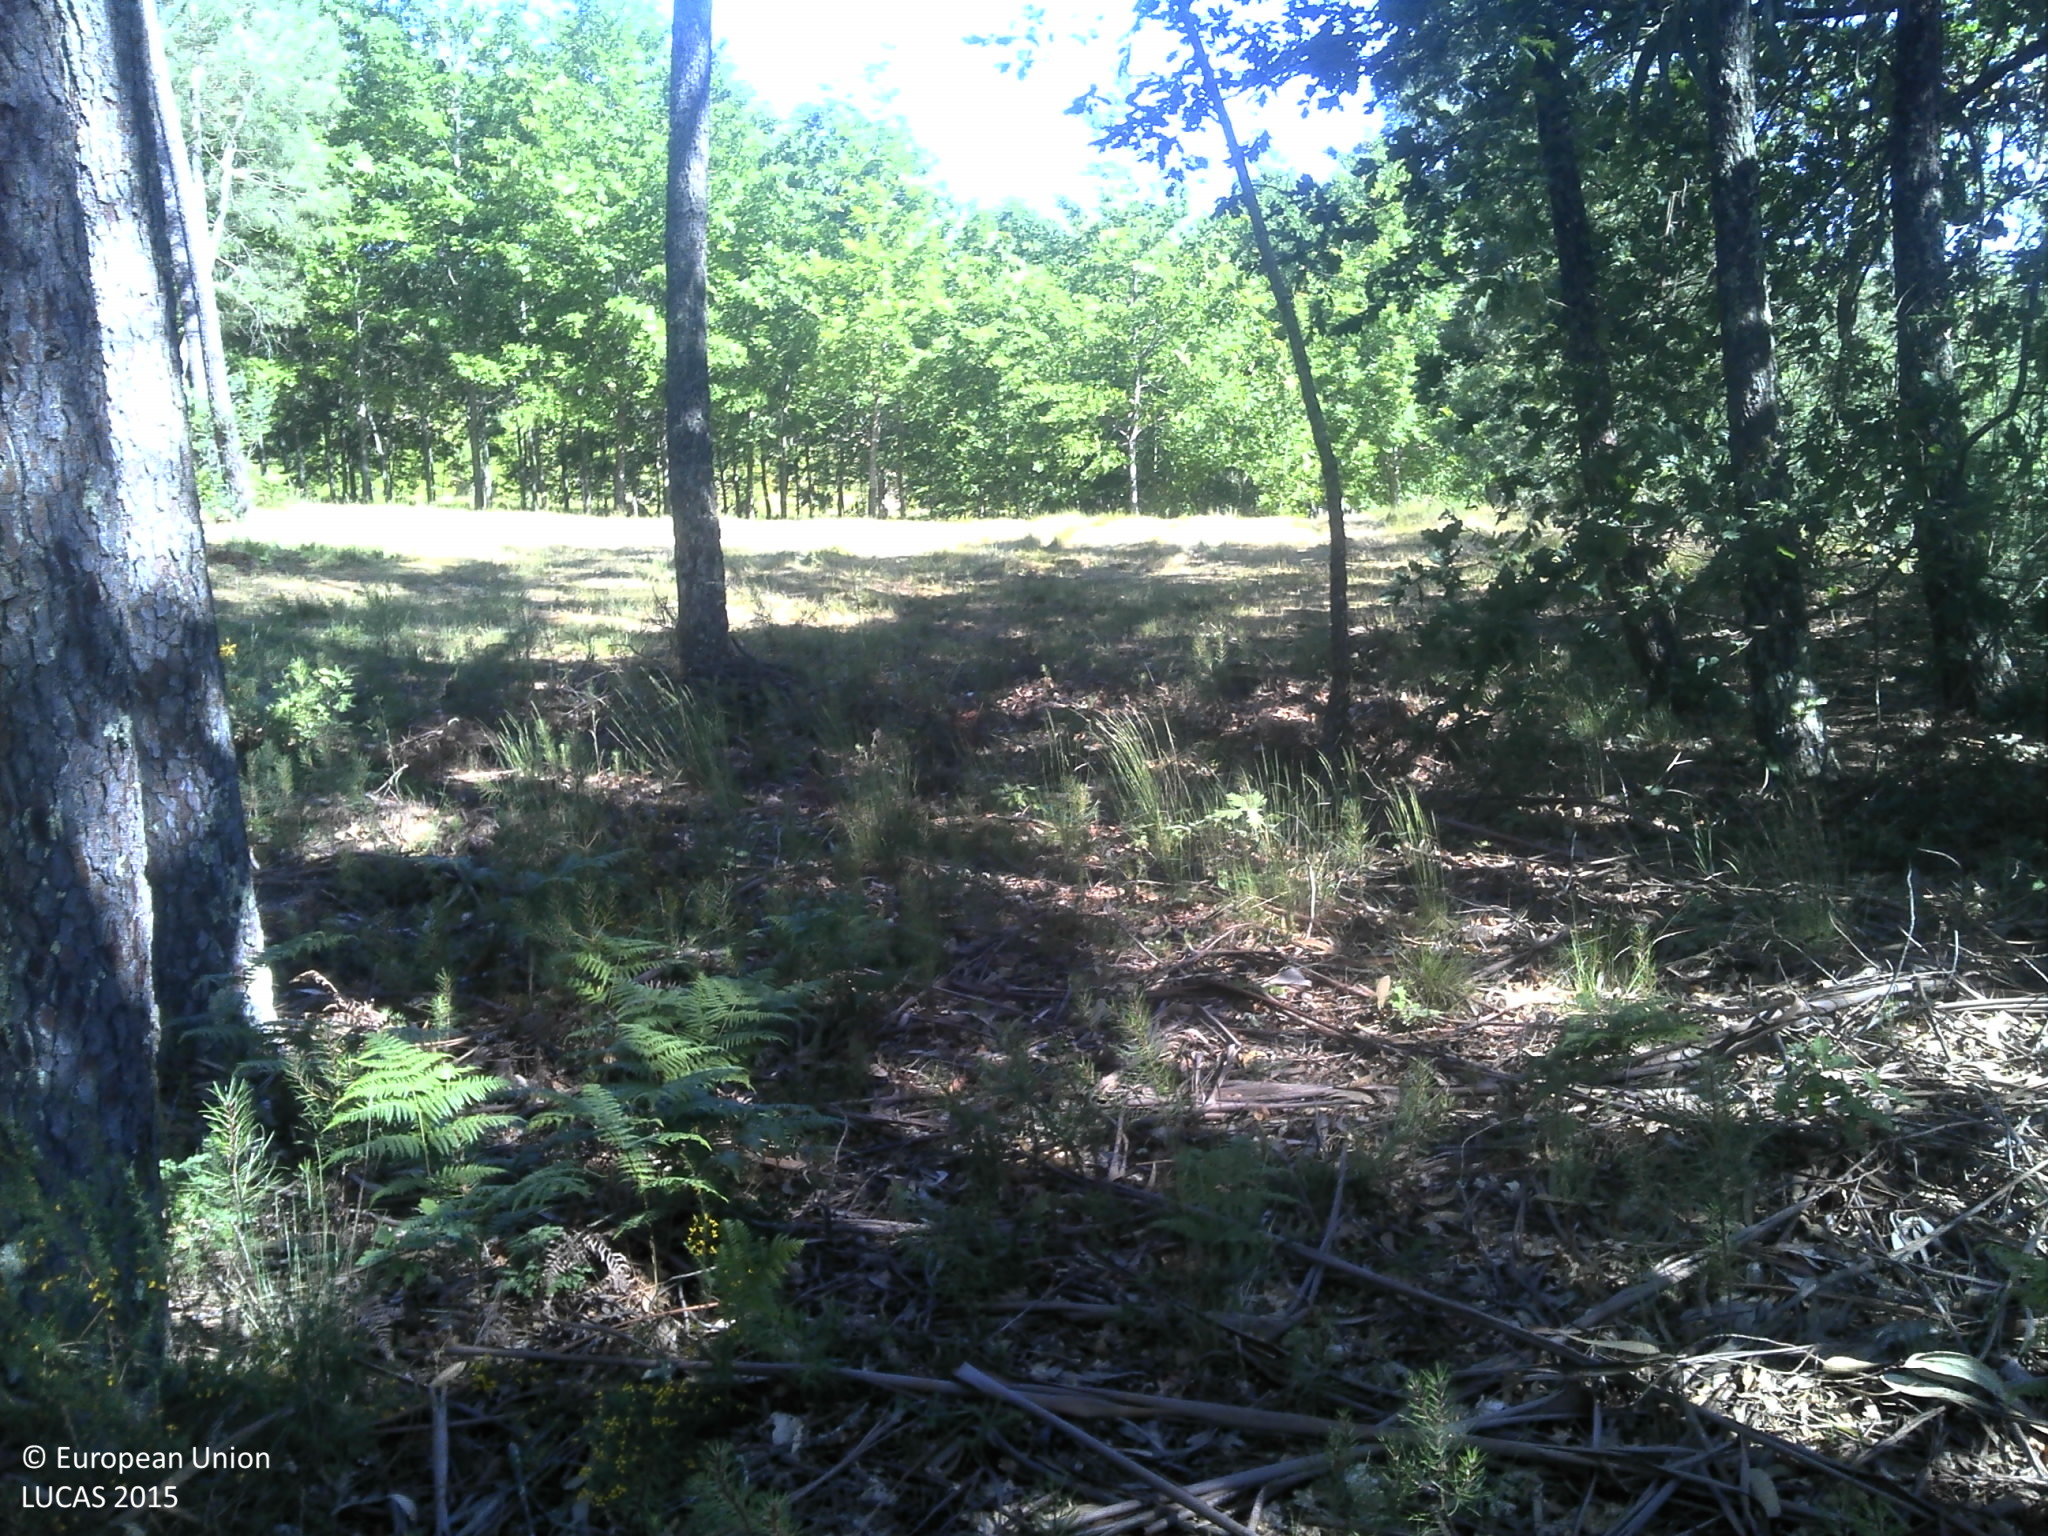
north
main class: Woodland
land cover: Pine dominated coniferous woodland
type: coniferous forest of the mediterranean region
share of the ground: 50 - 75 %
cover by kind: coniferous forest trees 70 %, shrubs 20 %, unconsolidated bare surface 10 %
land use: Forestry
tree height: > 5 m
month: May
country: PT
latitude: 40.4628
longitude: -7.7476
